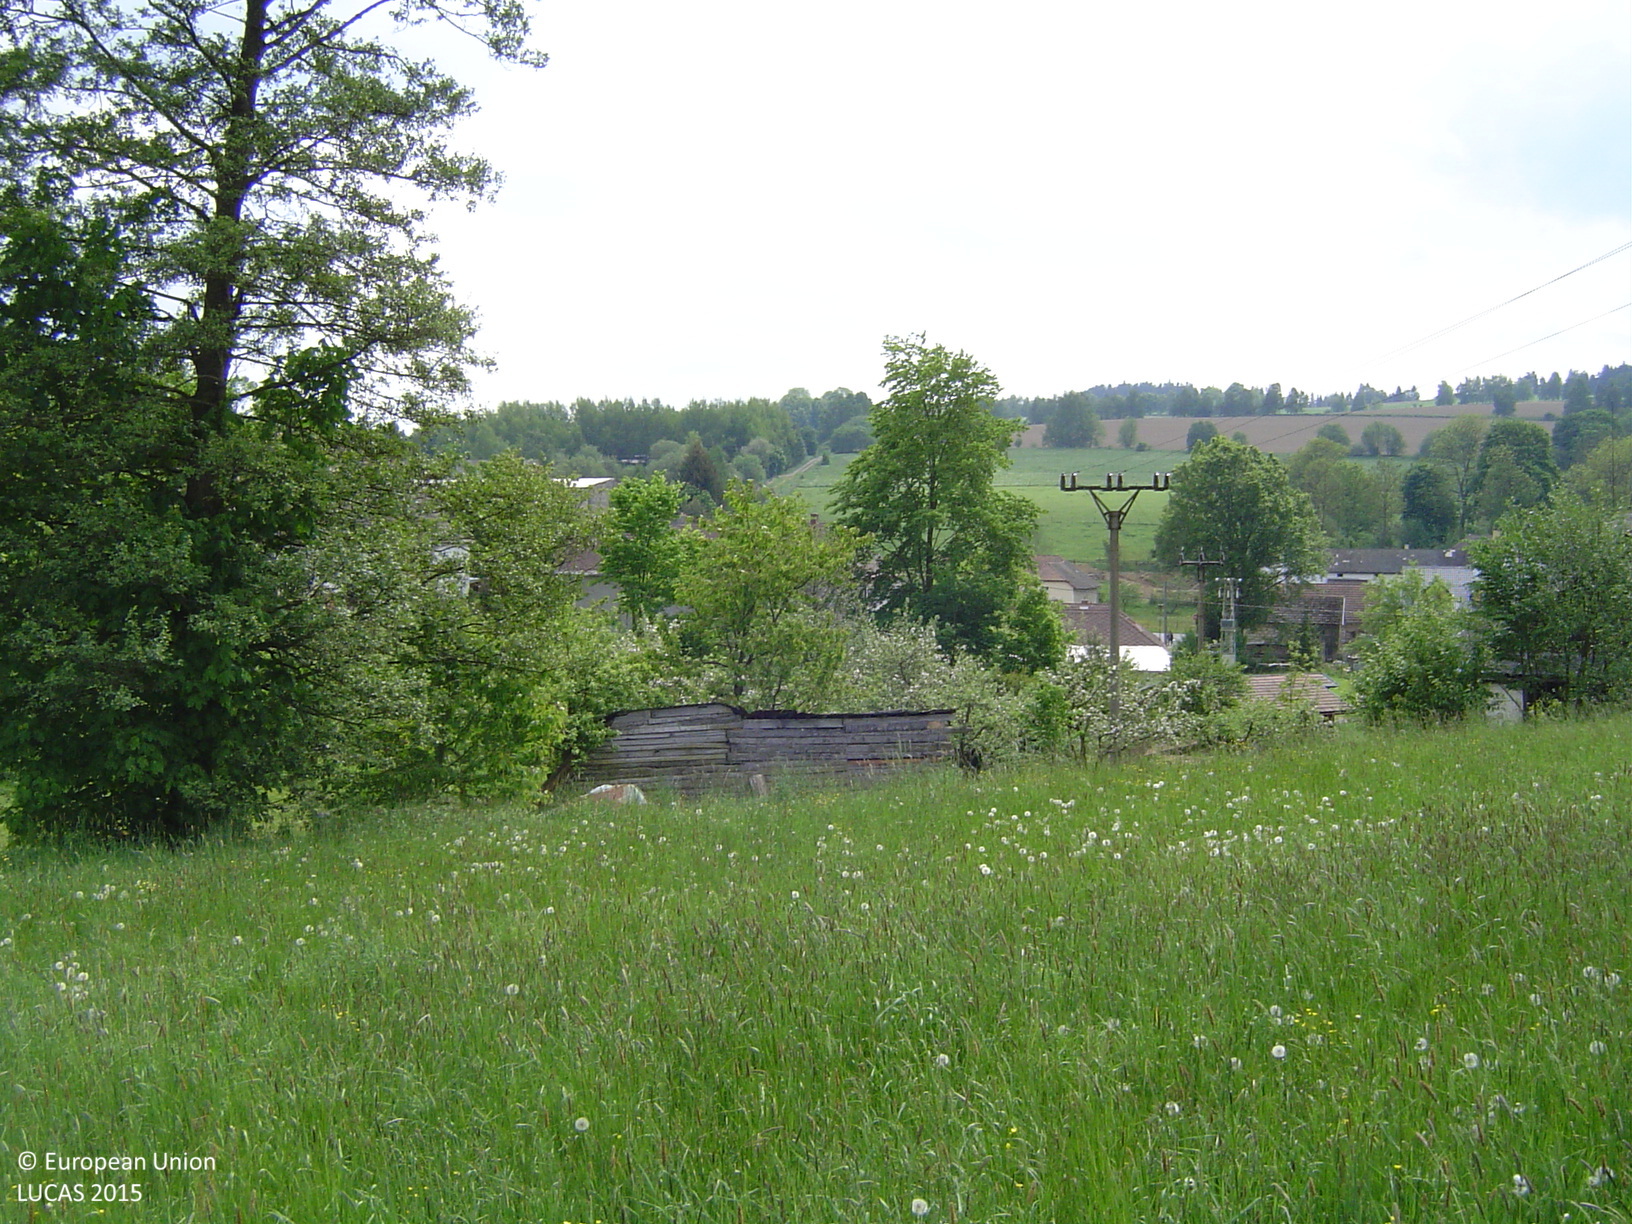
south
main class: Grassland
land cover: Grassland without tree/shrub cover
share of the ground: > 75 %
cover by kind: herbaceous plants 100 %
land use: Agriculture (excluding fallow land and kitchen gardens)
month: May
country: CZ
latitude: 49.6698
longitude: 16.2555
